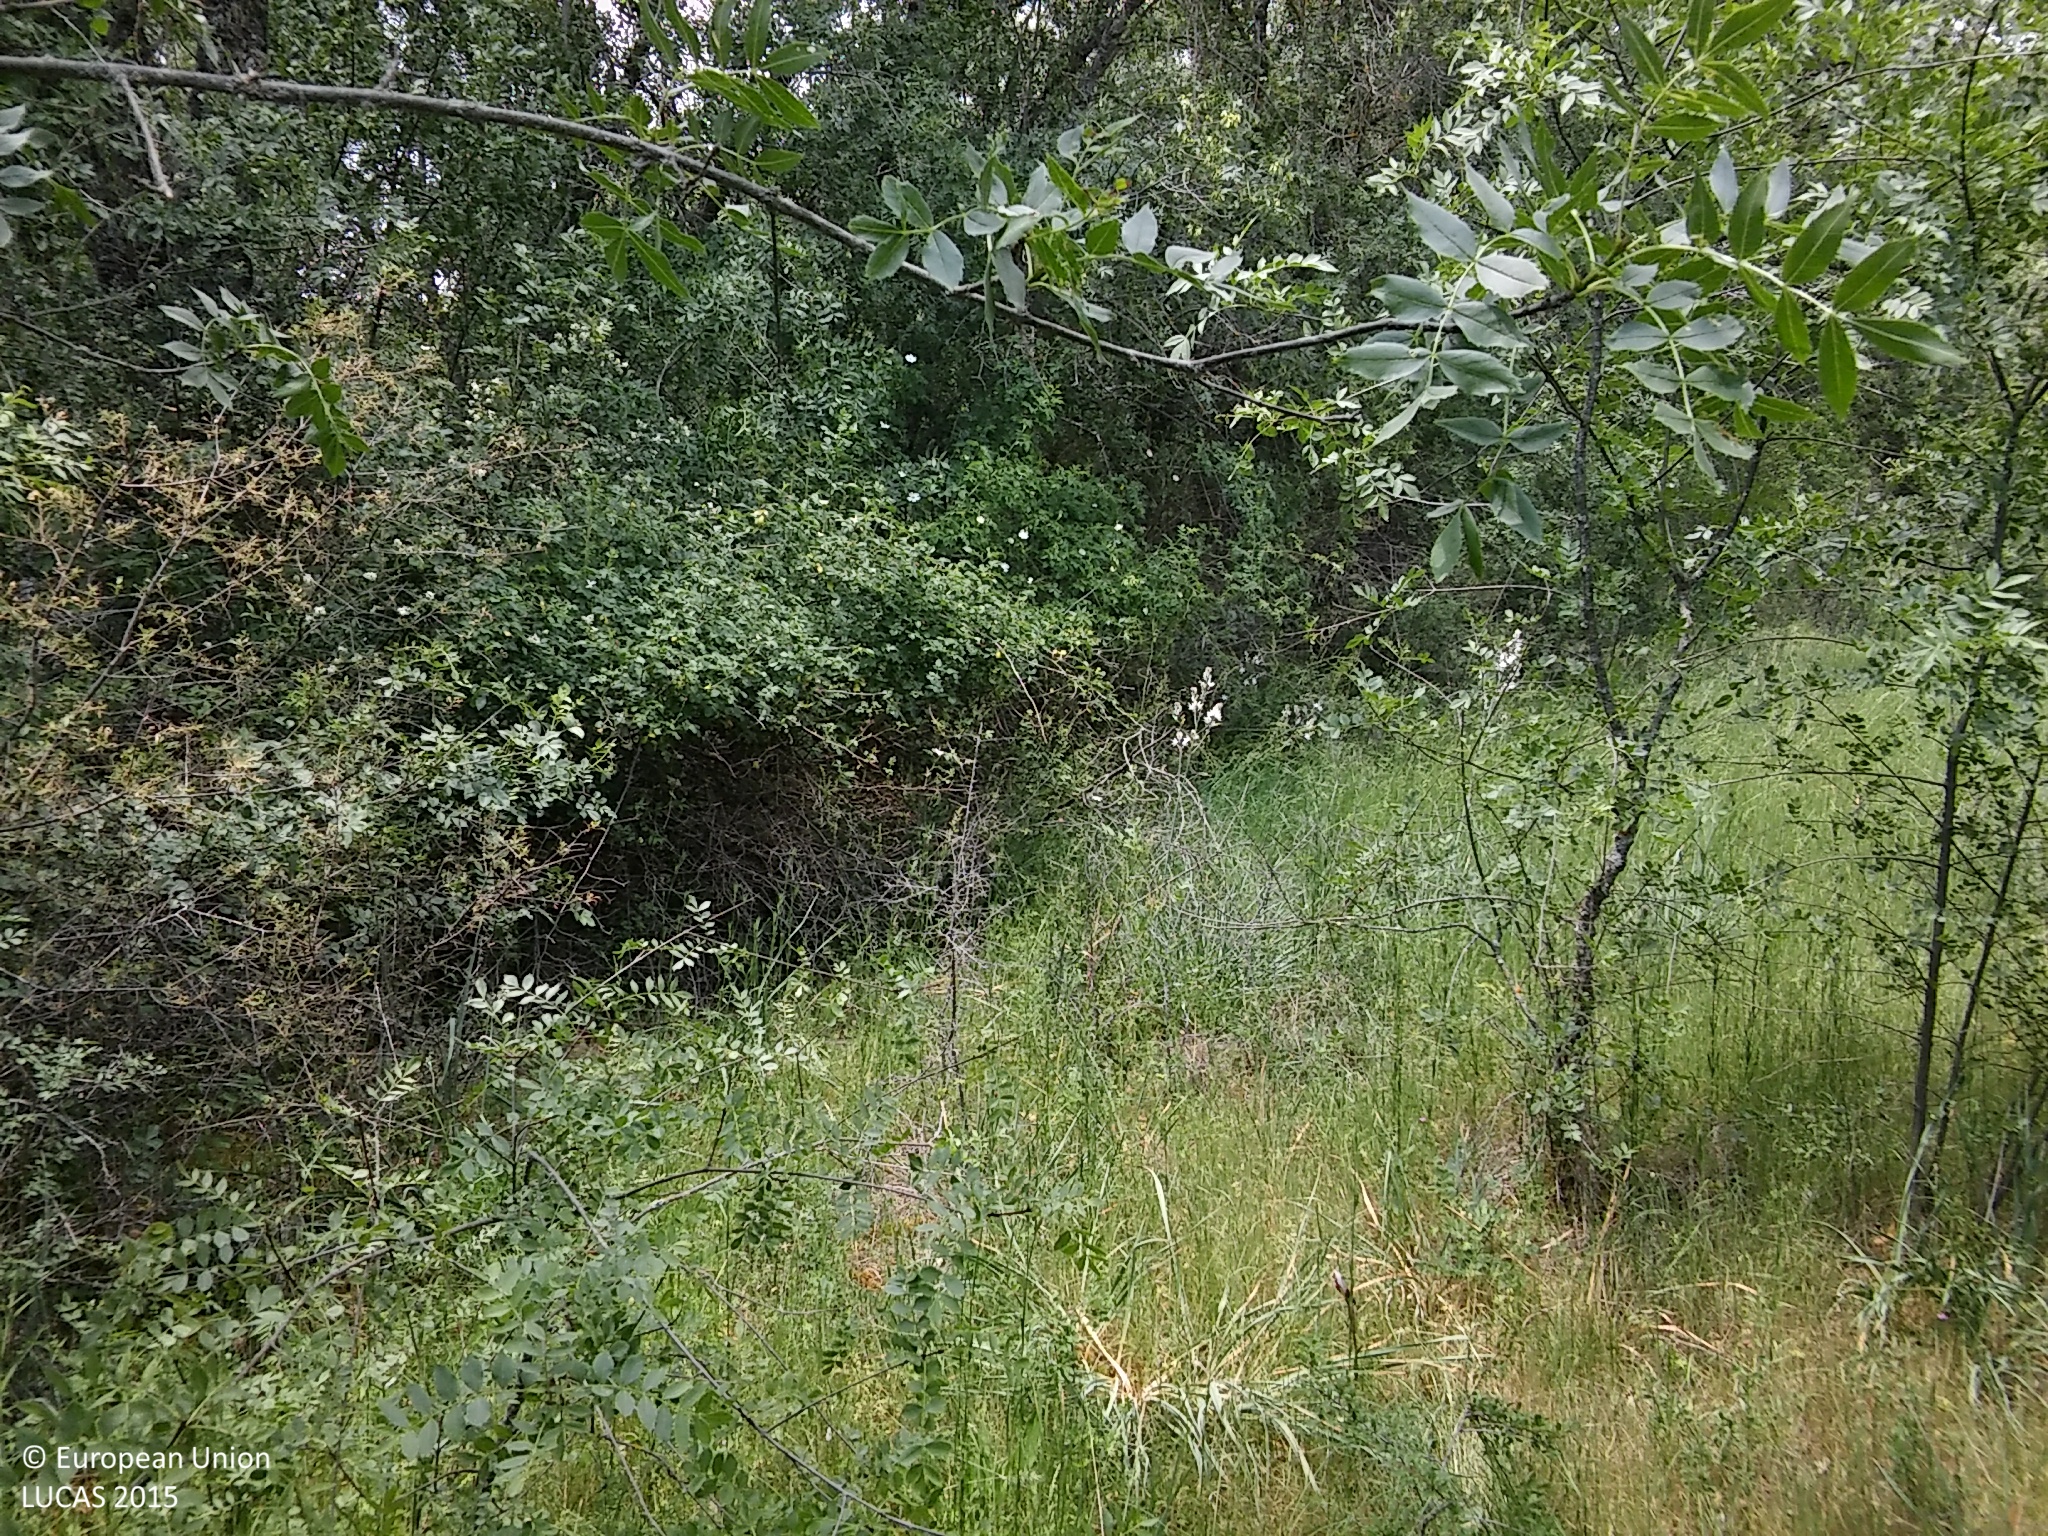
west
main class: Woodland
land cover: Broadleaved woodland
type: non-riverine alder, birch or aspen forest
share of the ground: 25 - 50 %
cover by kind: herbaceous plants 60 %, broadleaved forest trees 25 %, shrubs 15 %
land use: Abandoned areas
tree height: > 5 m
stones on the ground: < 10 %
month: June
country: ES
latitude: 41.1490
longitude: -3.7138
